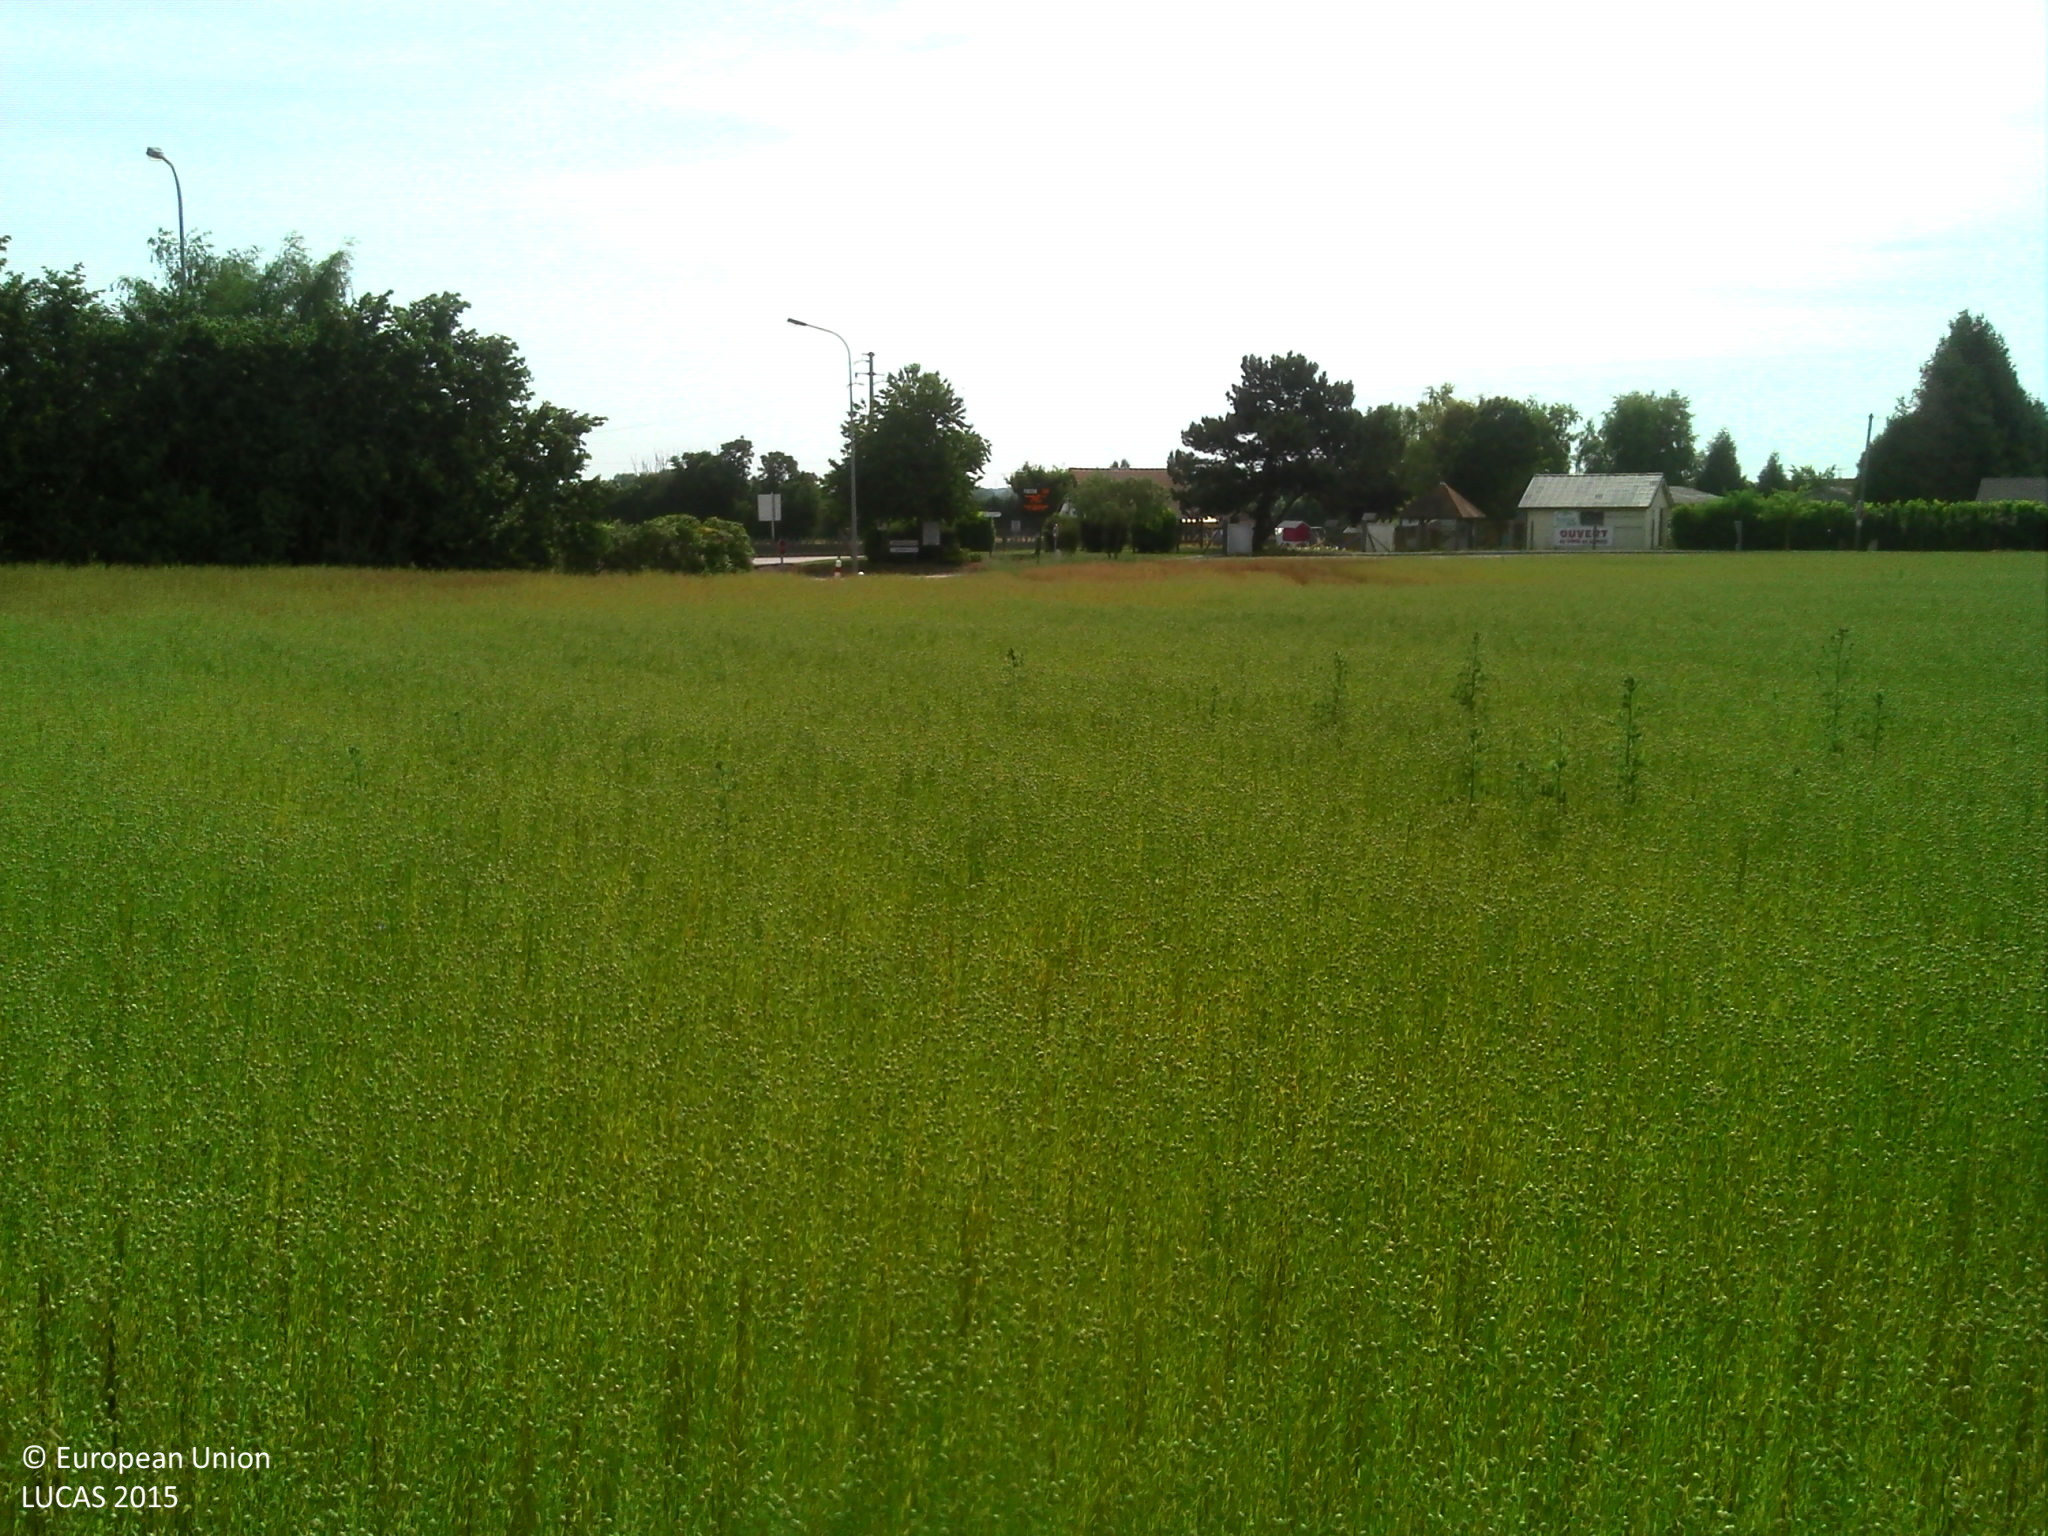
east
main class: Cropland
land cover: Other fibre and oleaginous crops
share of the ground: > 75 %
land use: Agriculture (excluding fallow land and kitchen gardens)
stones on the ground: < 10 %
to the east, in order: Other fibre and oleaginous crops; Ditches and canals; Paved roads, cycling and walking lanes; Artificial constructions; Ditches and canals; Grassland without tree/shrub cover; Single bushes/trees; Grassland without tree/shrub cover; Fences; Artificial constructions; Paved roads, cycling and walking lanes; Grass margins; Broadleaved woodland; Grassland without tree/shrub cover; Barley
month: June
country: FR
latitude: 49.1413
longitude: -0.2458
